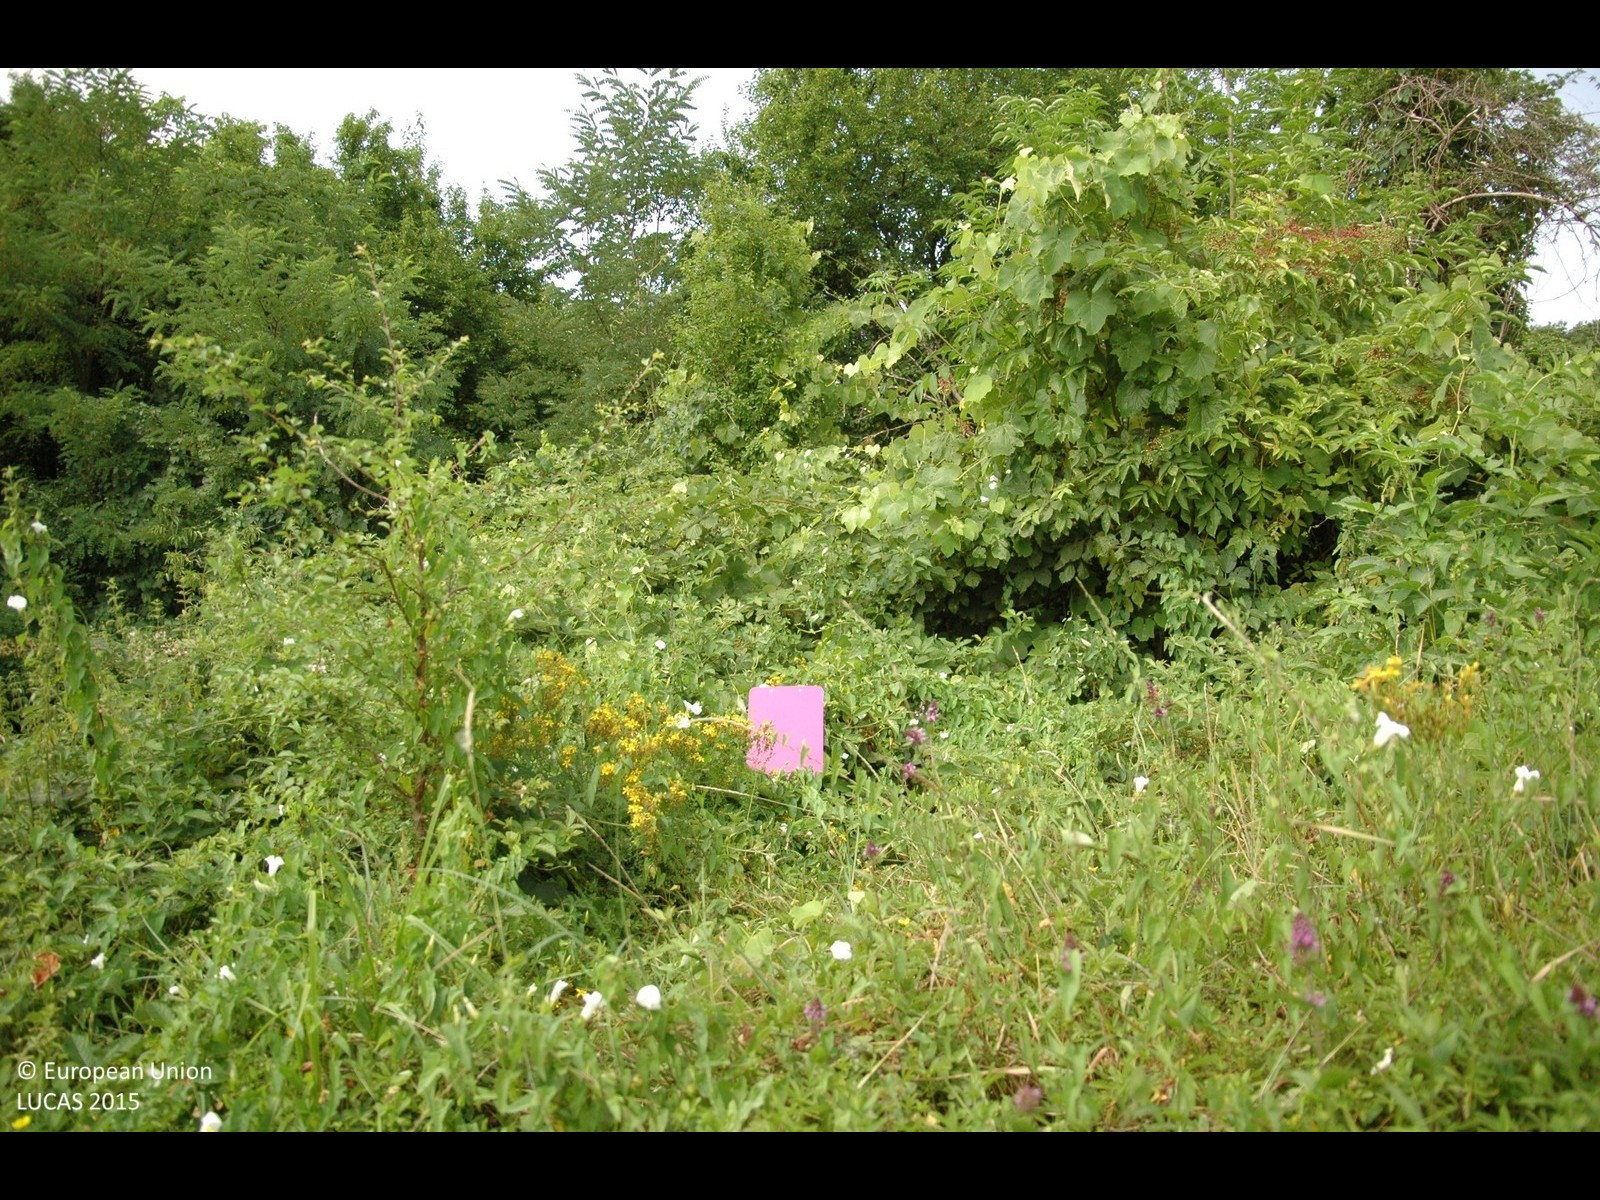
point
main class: Grassland
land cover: Spontaneously vegetated surfaces
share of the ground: > 75 %
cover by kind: herbaceous plants 95 %, shrubs 5 %
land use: Abandoned areas
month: July
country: HR
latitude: 46.0859
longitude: 16.1160
